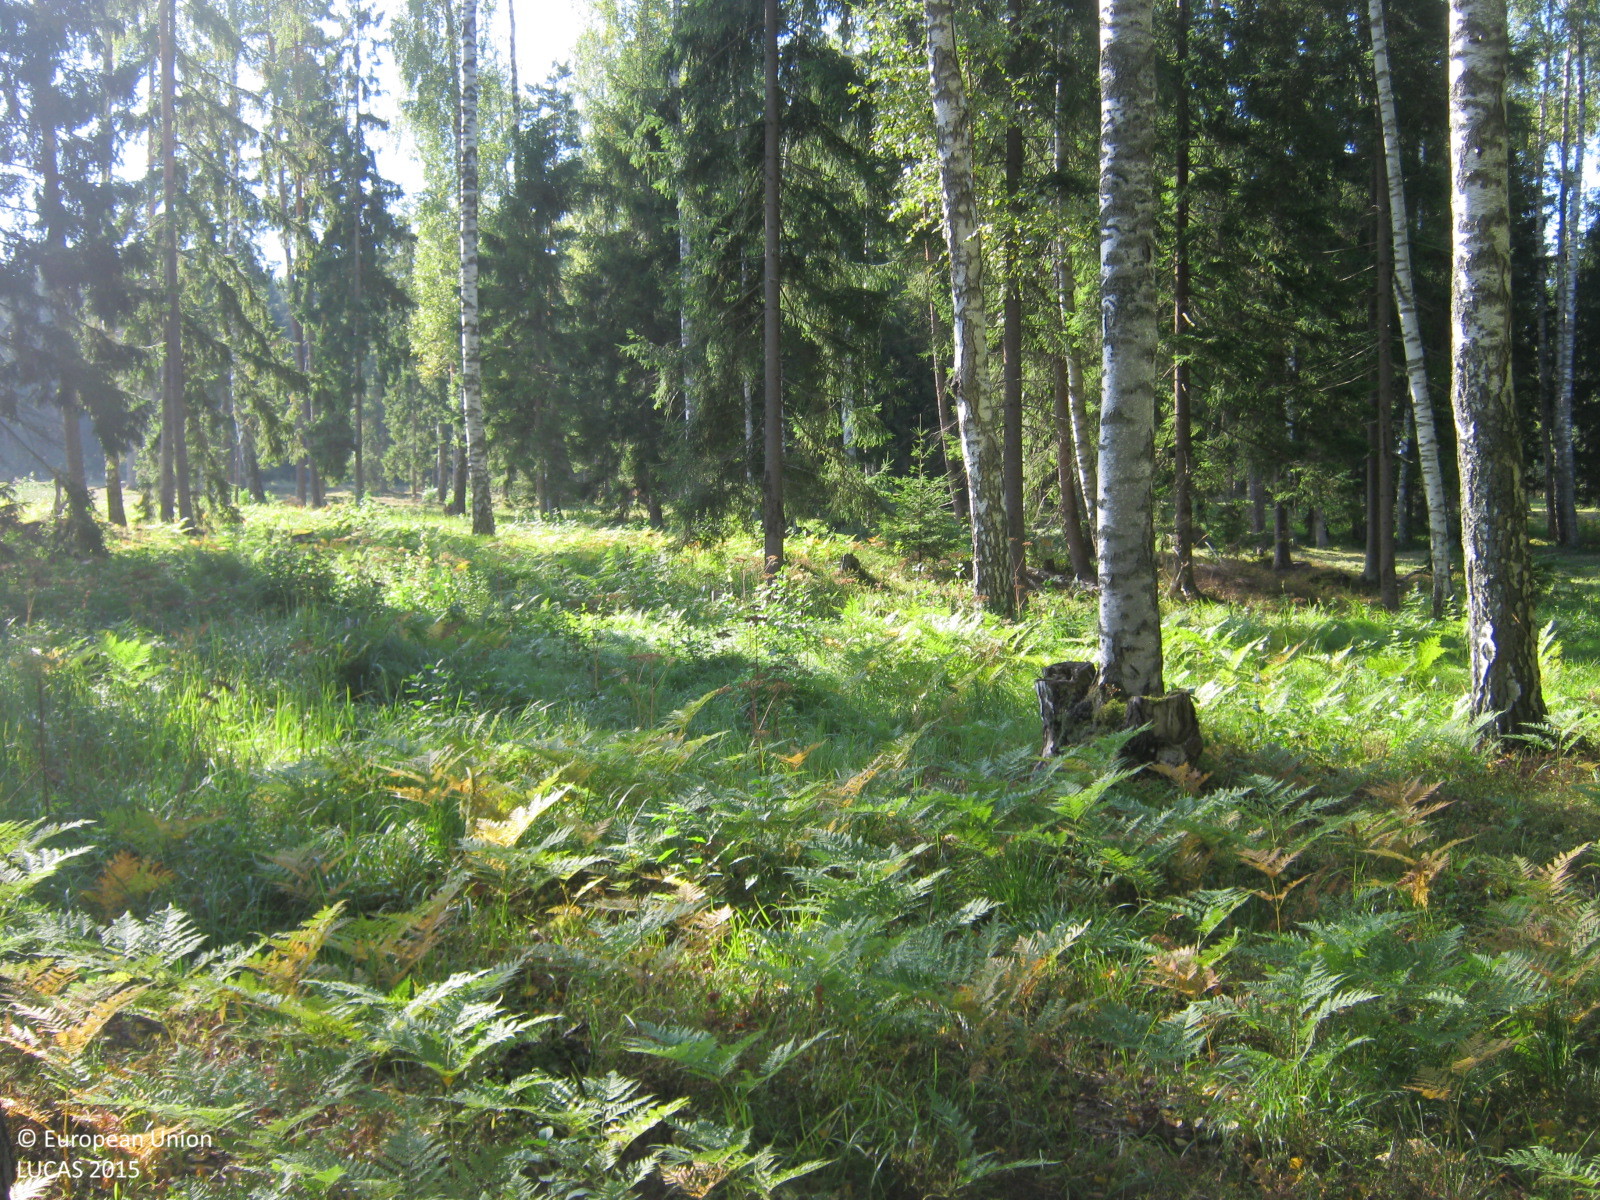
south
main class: Woodland
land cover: Spruce dominated mixed woodland
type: hemiboreal forest and nemoral coniferous forest and mixed broadleaved-coniferous forest
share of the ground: > 75 %
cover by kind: coniferous forest trees 50 %, broadleaved forest trees 30 %, herbaceous plants 20 %
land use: Forestry
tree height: > 5 m
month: September
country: LV
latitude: 57.3257
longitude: 24.4231
